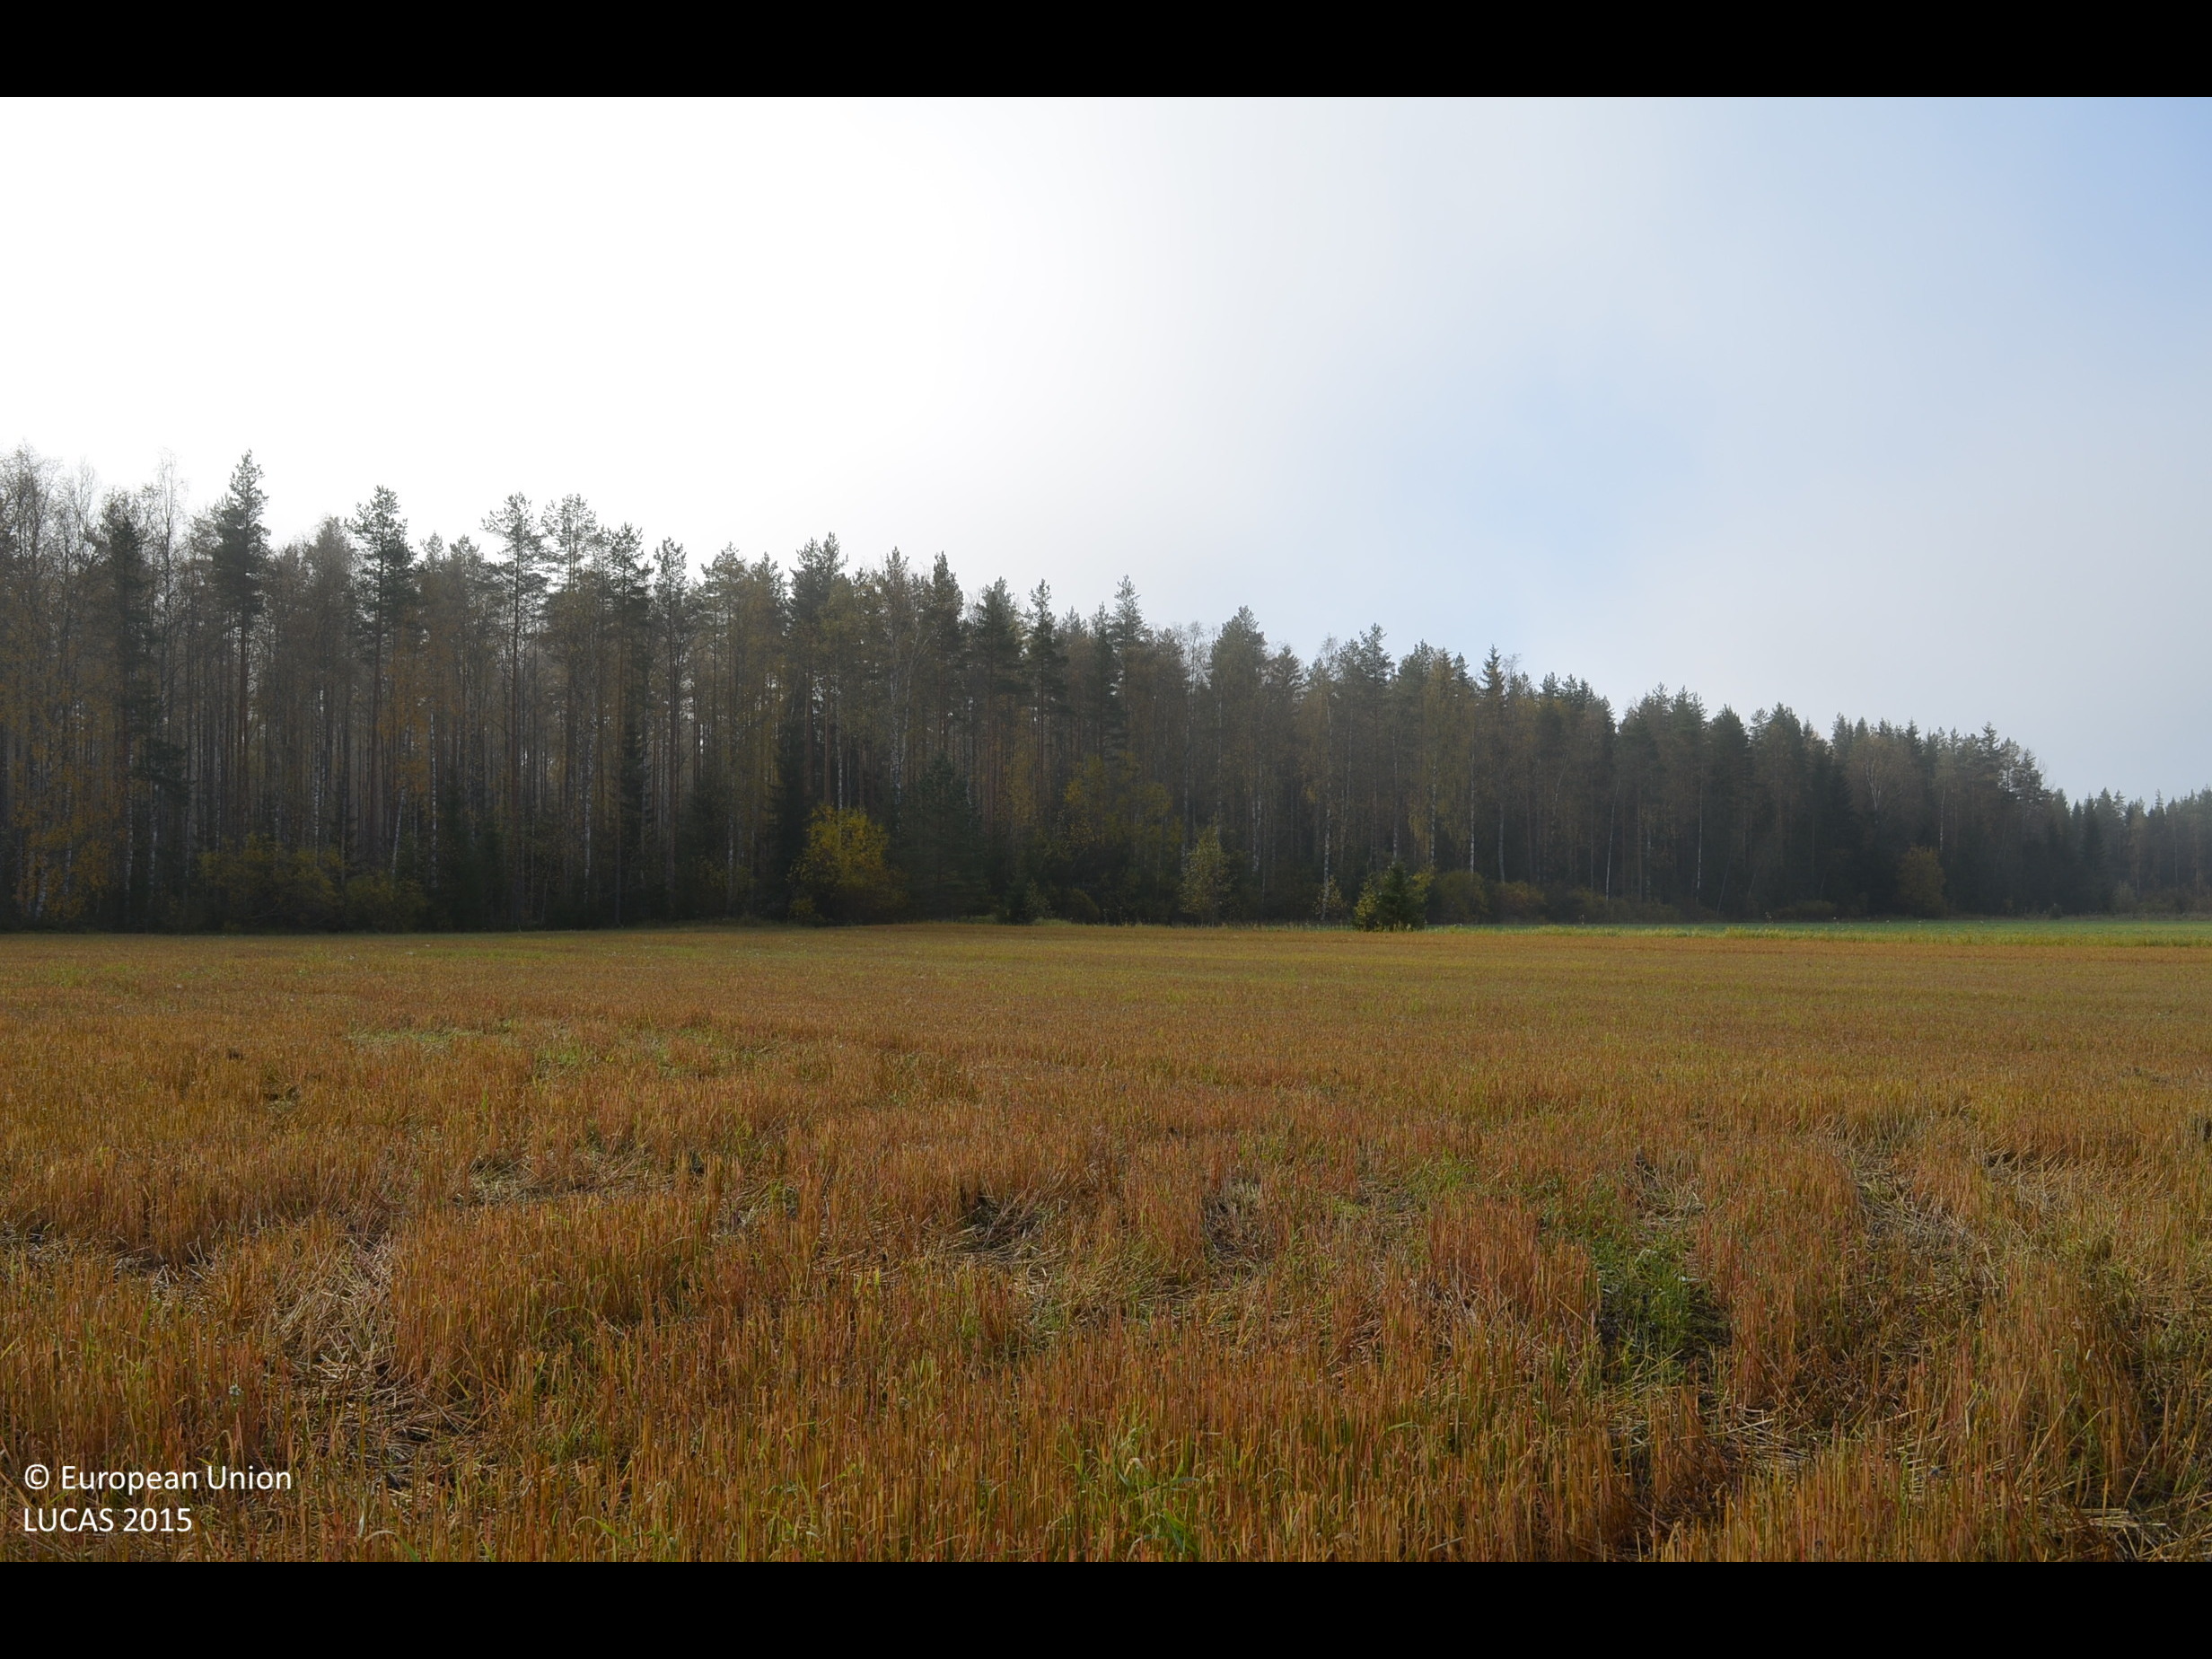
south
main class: Cropland
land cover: Oats
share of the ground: > 75 %
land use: Agriculture (excluding fallow land and kitchen gardens)
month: September
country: FI
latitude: 62.5998
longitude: 23.5694
